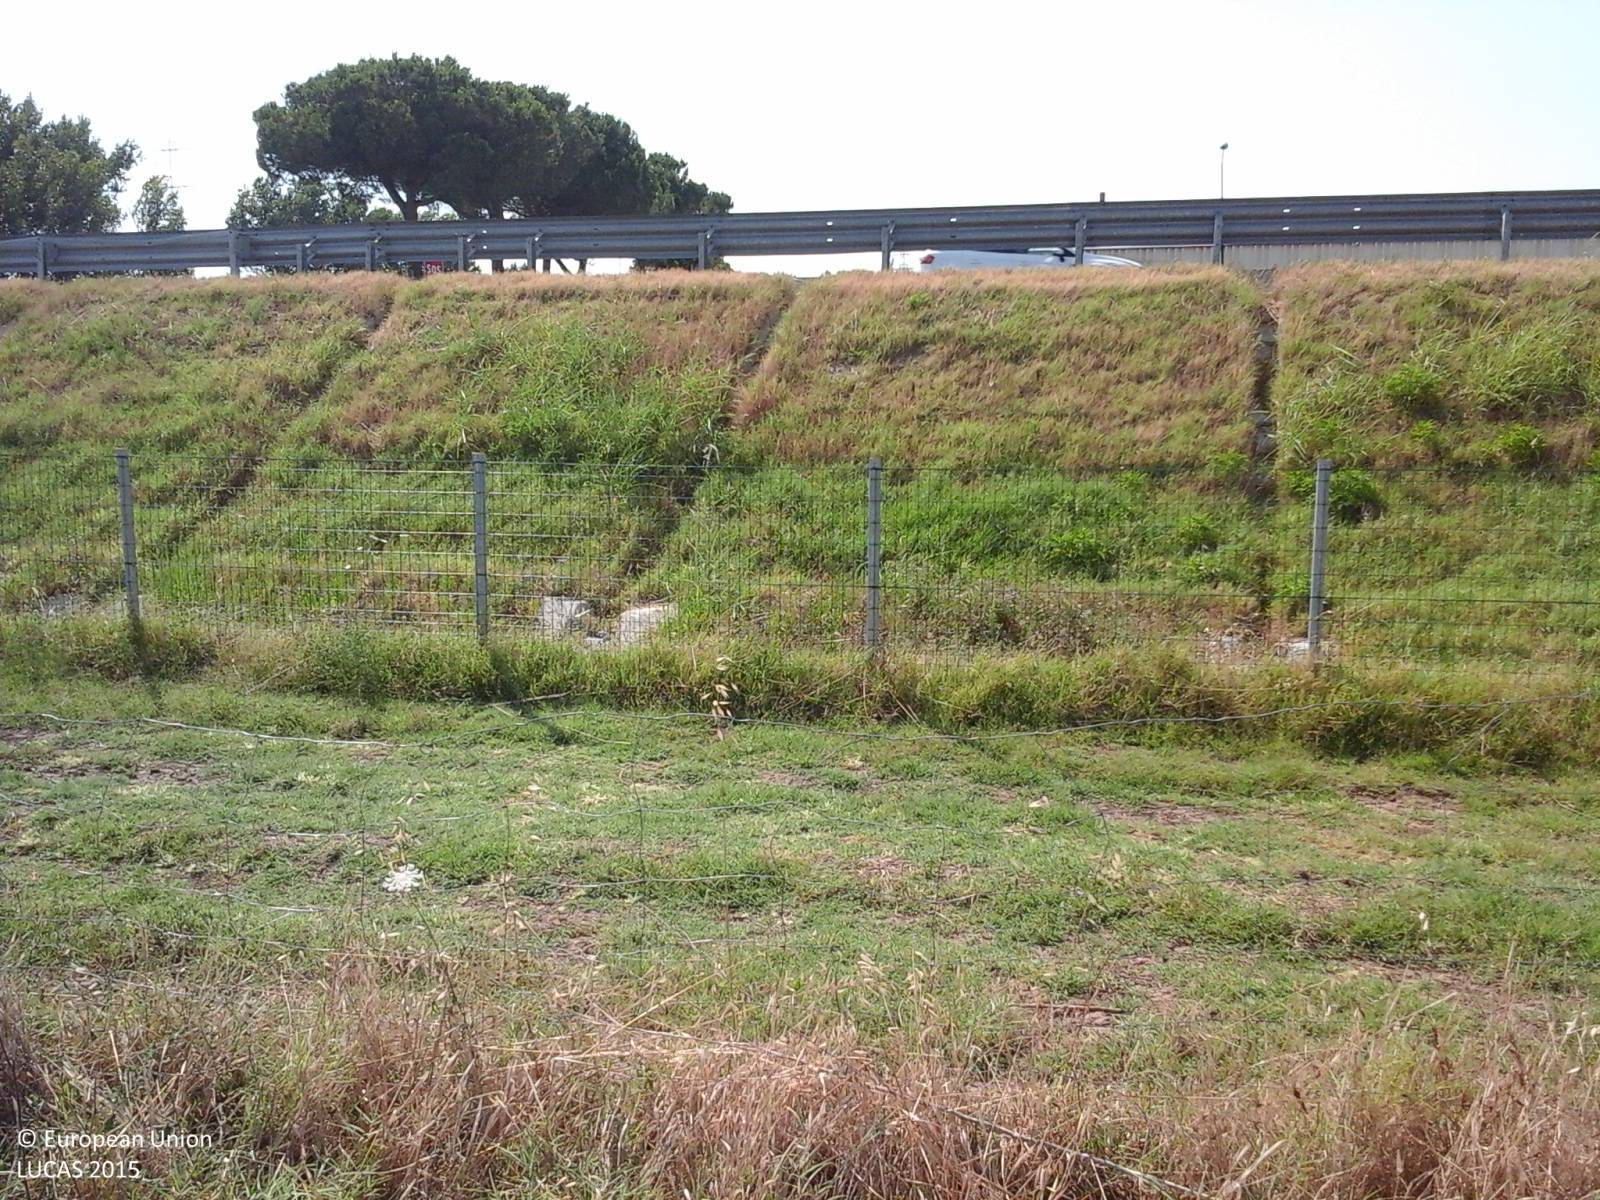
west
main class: Cropland
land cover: Durum wheat
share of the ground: < 10 %
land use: Agriculture (excluding fallow land and kitchen gardens)
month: July
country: IT
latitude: 42.1148
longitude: 12.5911
